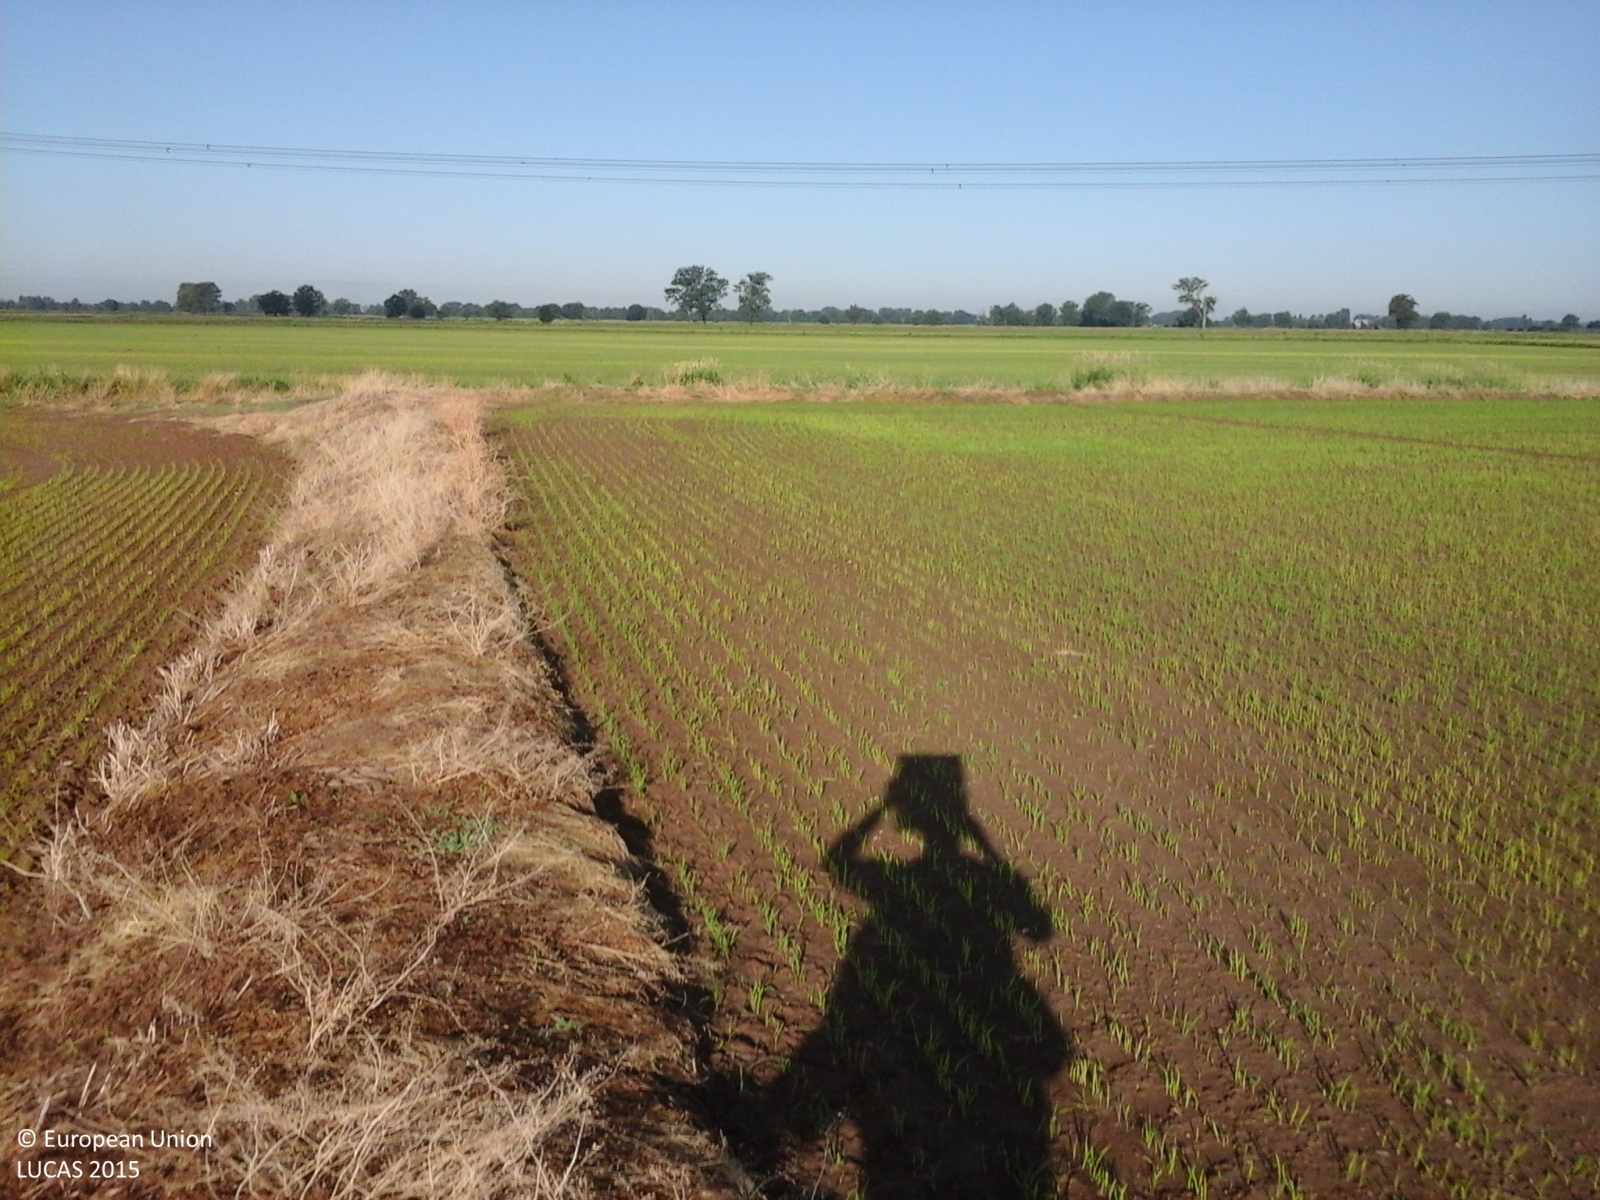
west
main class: Cropland
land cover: Rice
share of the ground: 10 - 25 %
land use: Agriculture (excluding fallow land and kitchen gardens)
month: May
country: IT
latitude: 45.3744
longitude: 9.0950
